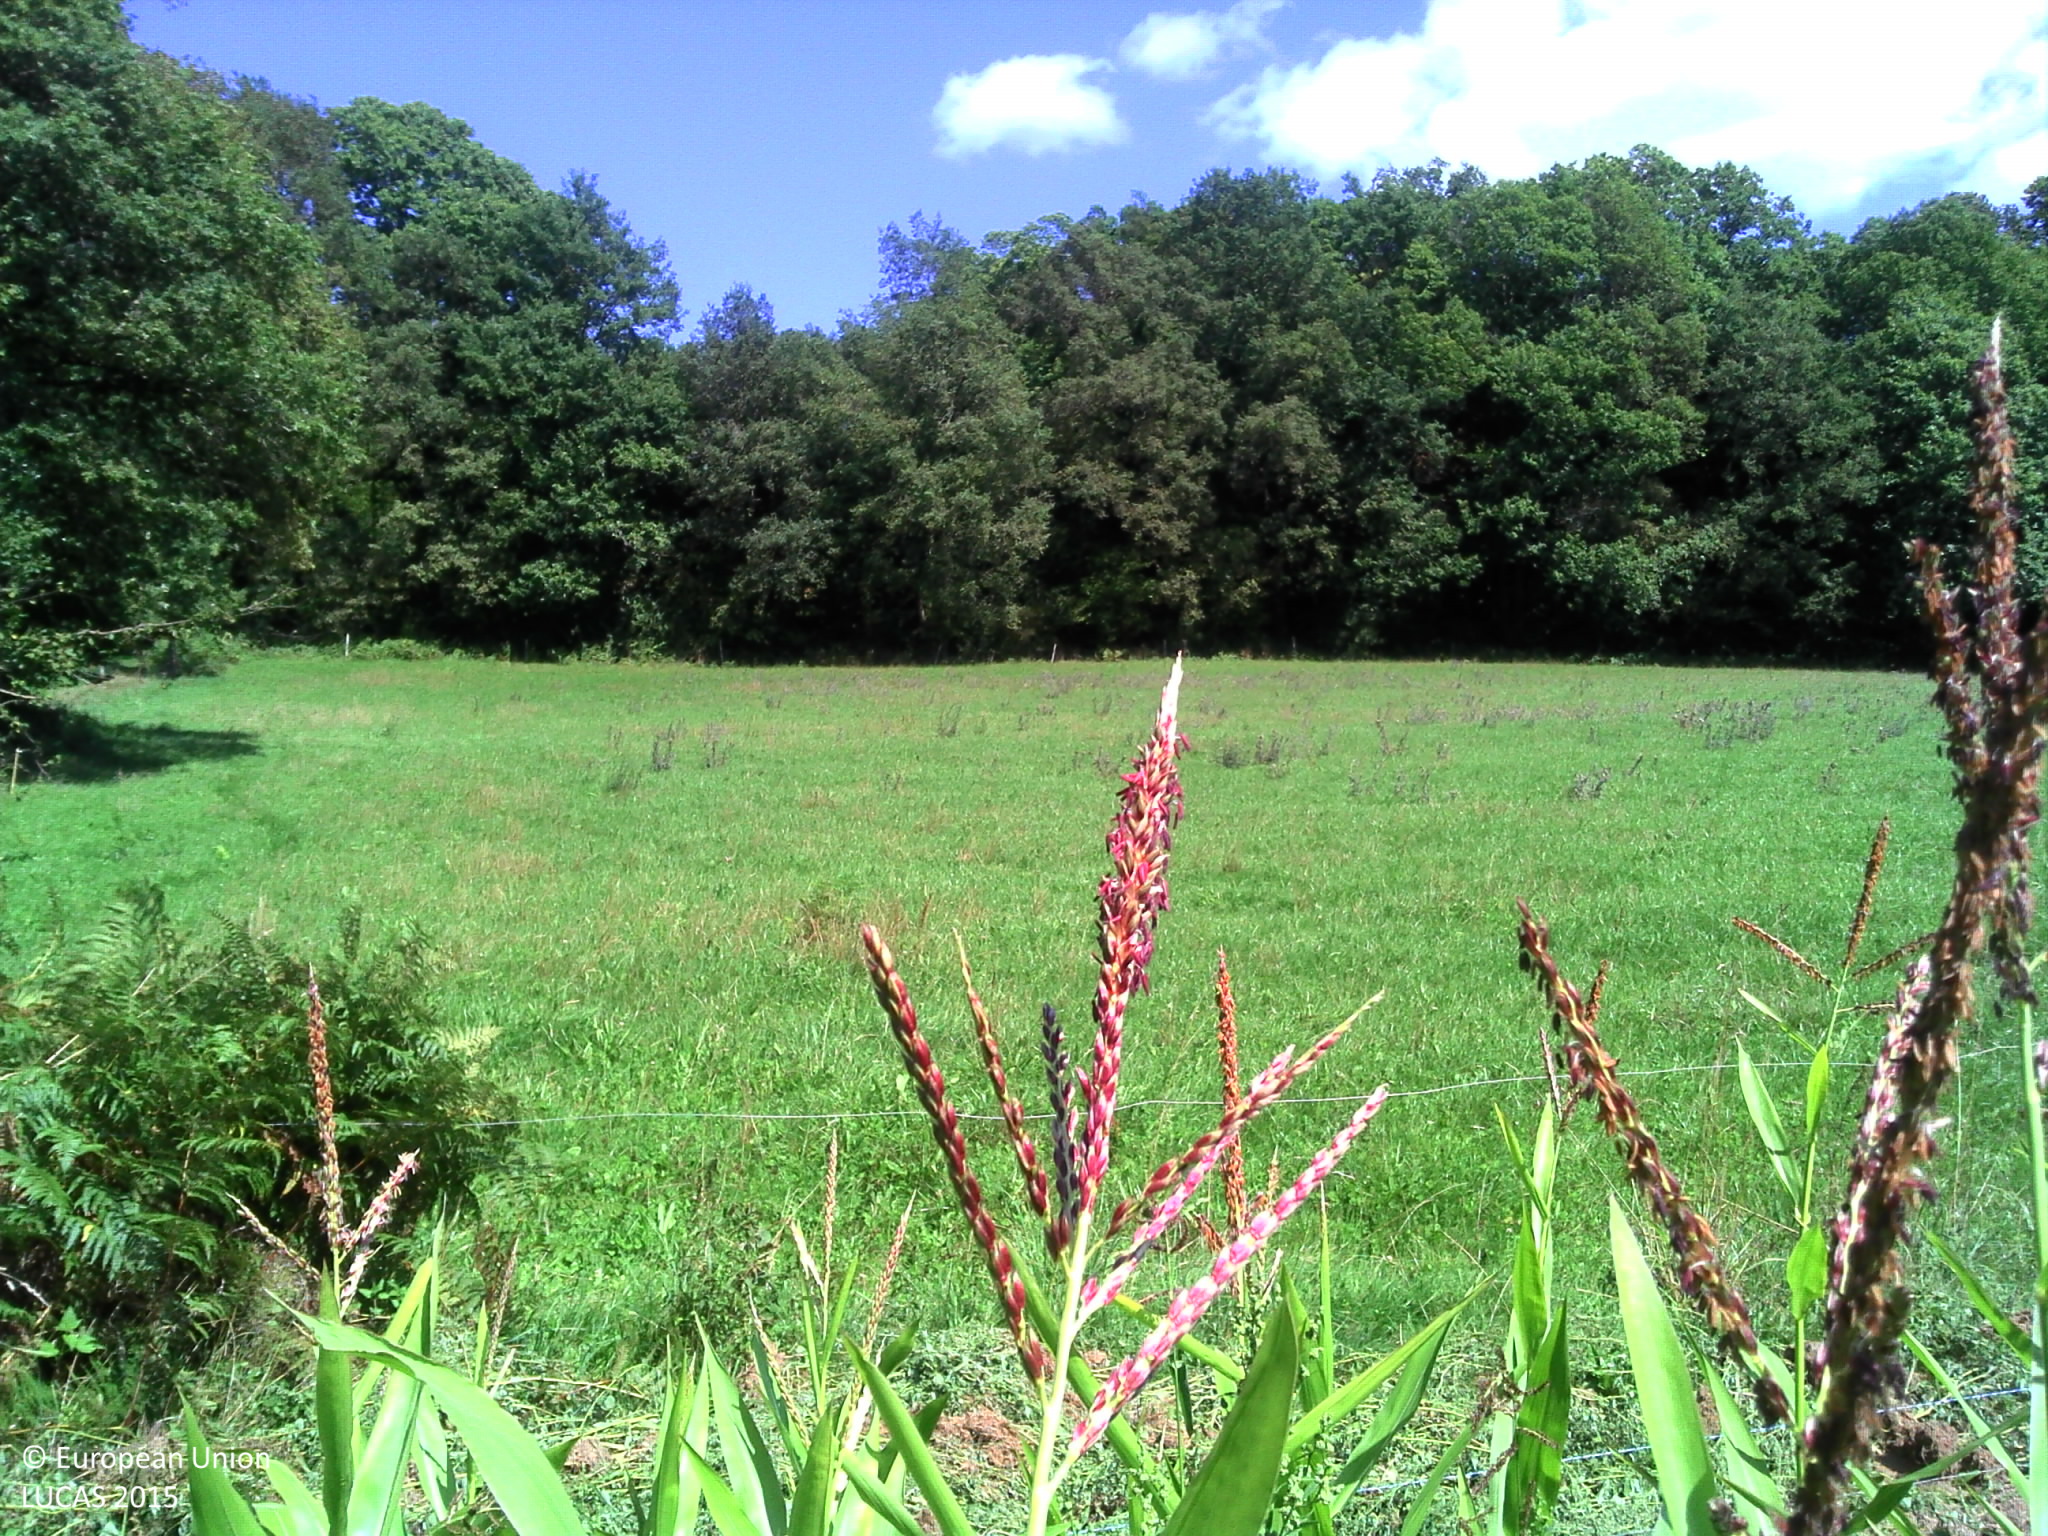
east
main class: Cropland
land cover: Maize
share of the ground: 50 - 75 %
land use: Agriculture (excluding fallow land and kitchen gardens)
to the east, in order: Maize; Fences; Grass margins; Fences; Temporary grasslands; Fences; Broadleaved woodland; Tracks; Broadleaved woodland; Fences; Broadleaved woodland; Ponds and wetlands; Broadleaved woodland; Grassland without tree/shrub cover
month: August
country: FR
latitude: 45.8661
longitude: 1.7106
